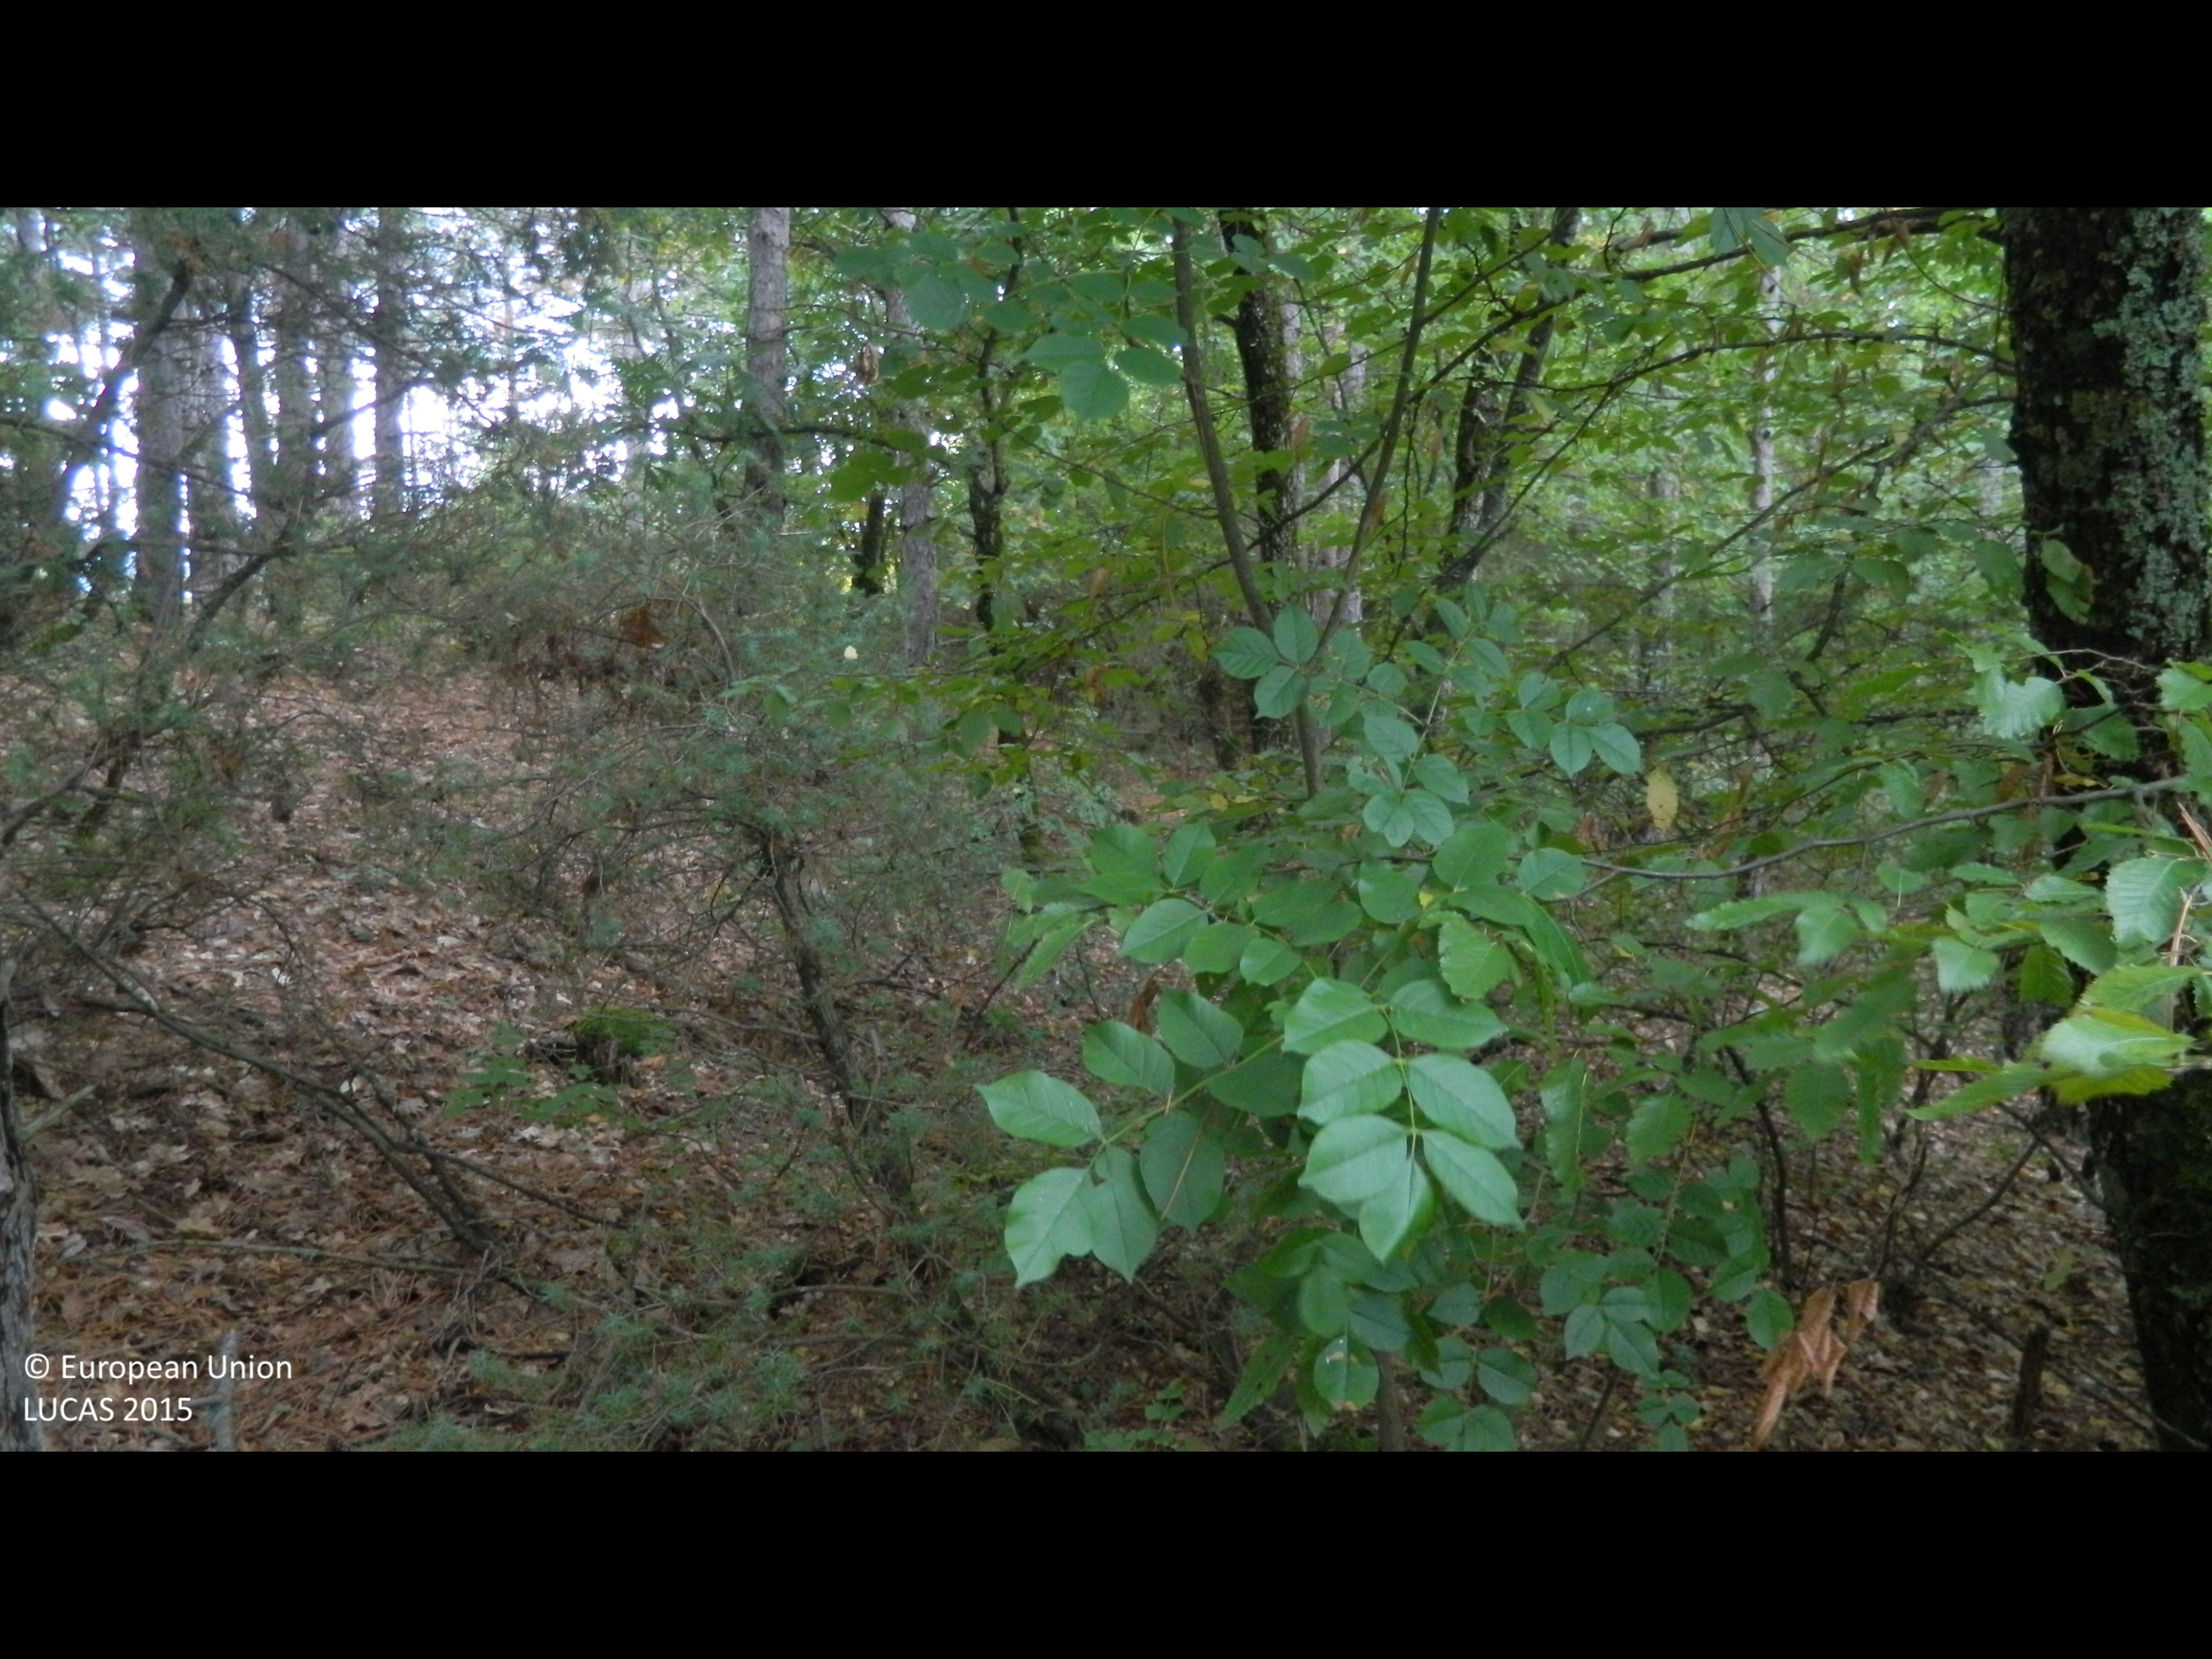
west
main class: Woodland
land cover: Pine dominated mixed woodland
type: hemiboreal forest and nemoral coniferous forest and mixed broadleaved-coniferous forest
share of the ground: > 75 %
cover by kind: coniferous forest trees 65 %, broadleaved forest trees 25 %, shrubs 5 %, unconsolidated bare surface 5 %
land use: Forestry
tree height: > 5 m
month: September
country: BG
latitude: 41.6465
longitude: 25.7817
